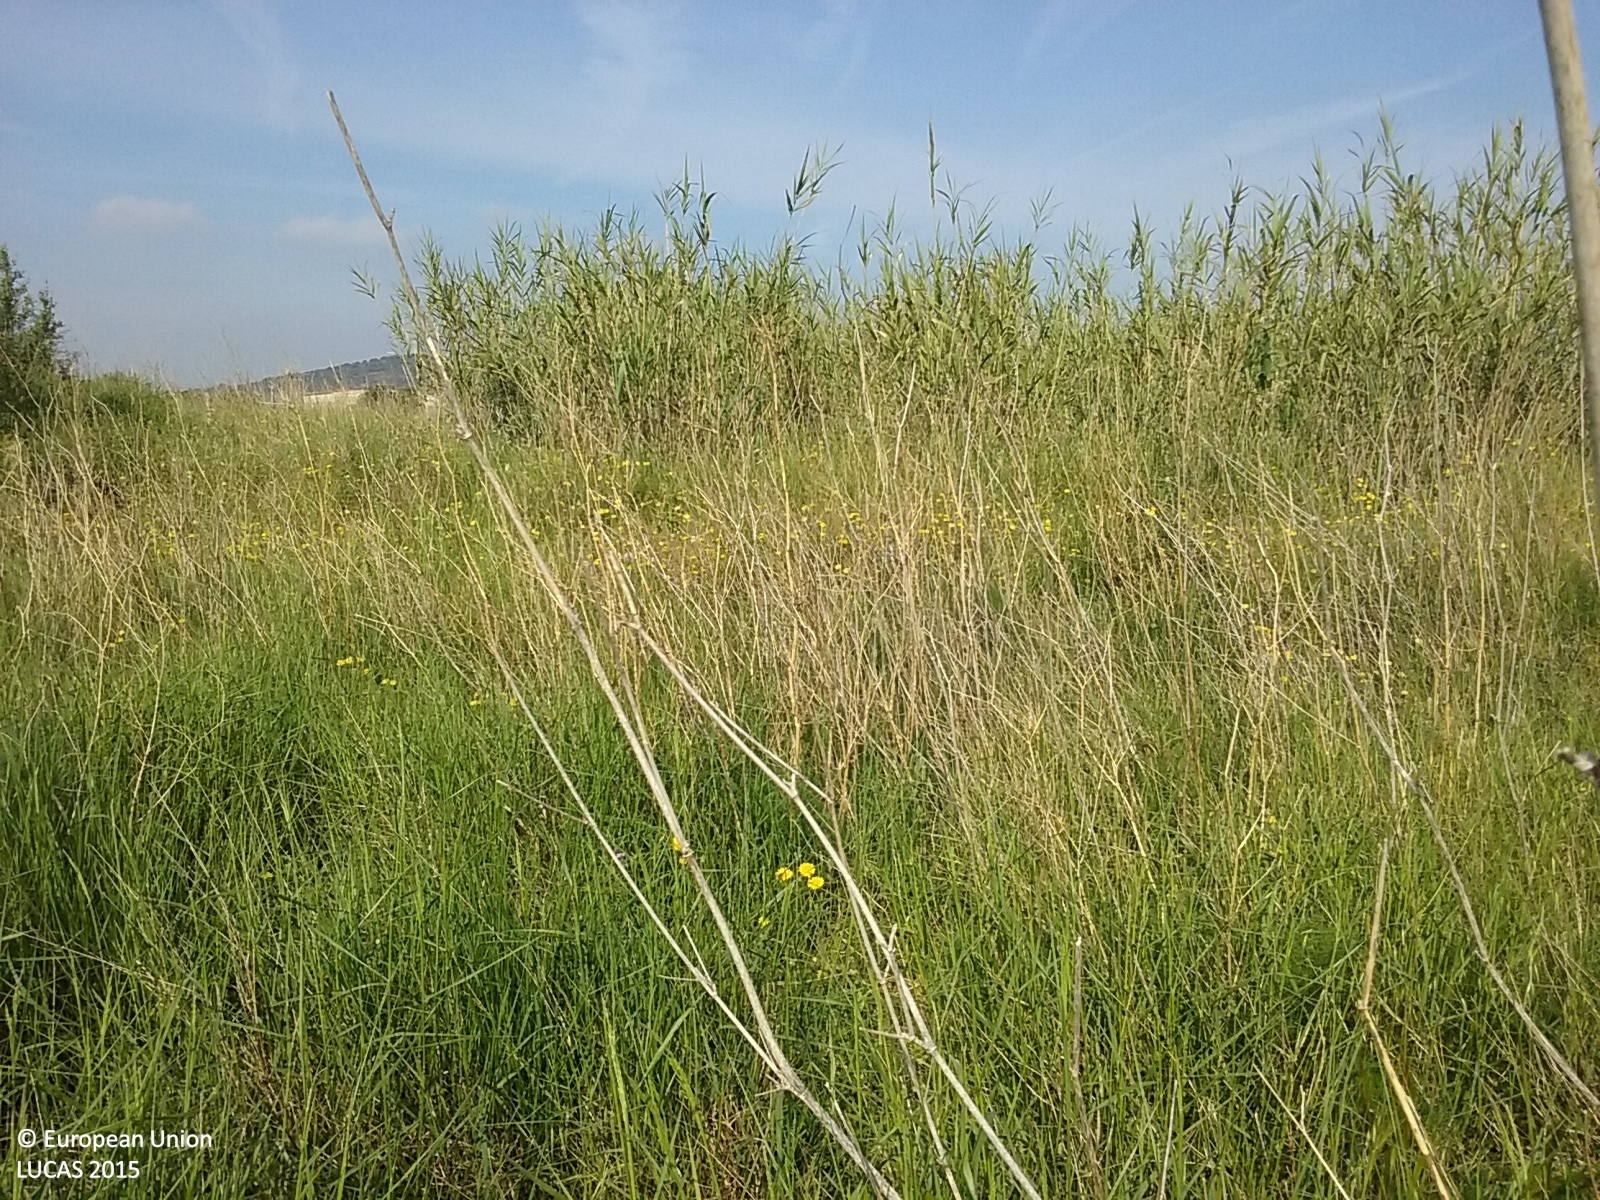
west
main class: Grassland
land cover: Grassland without tree/shrub cover
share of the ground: > 75 %
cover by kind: herbaceous plants 100 %
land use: Abandoned areas
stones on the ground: 10 - 25 %
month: April
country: ES
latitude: 40.7436
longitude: 0.6035
